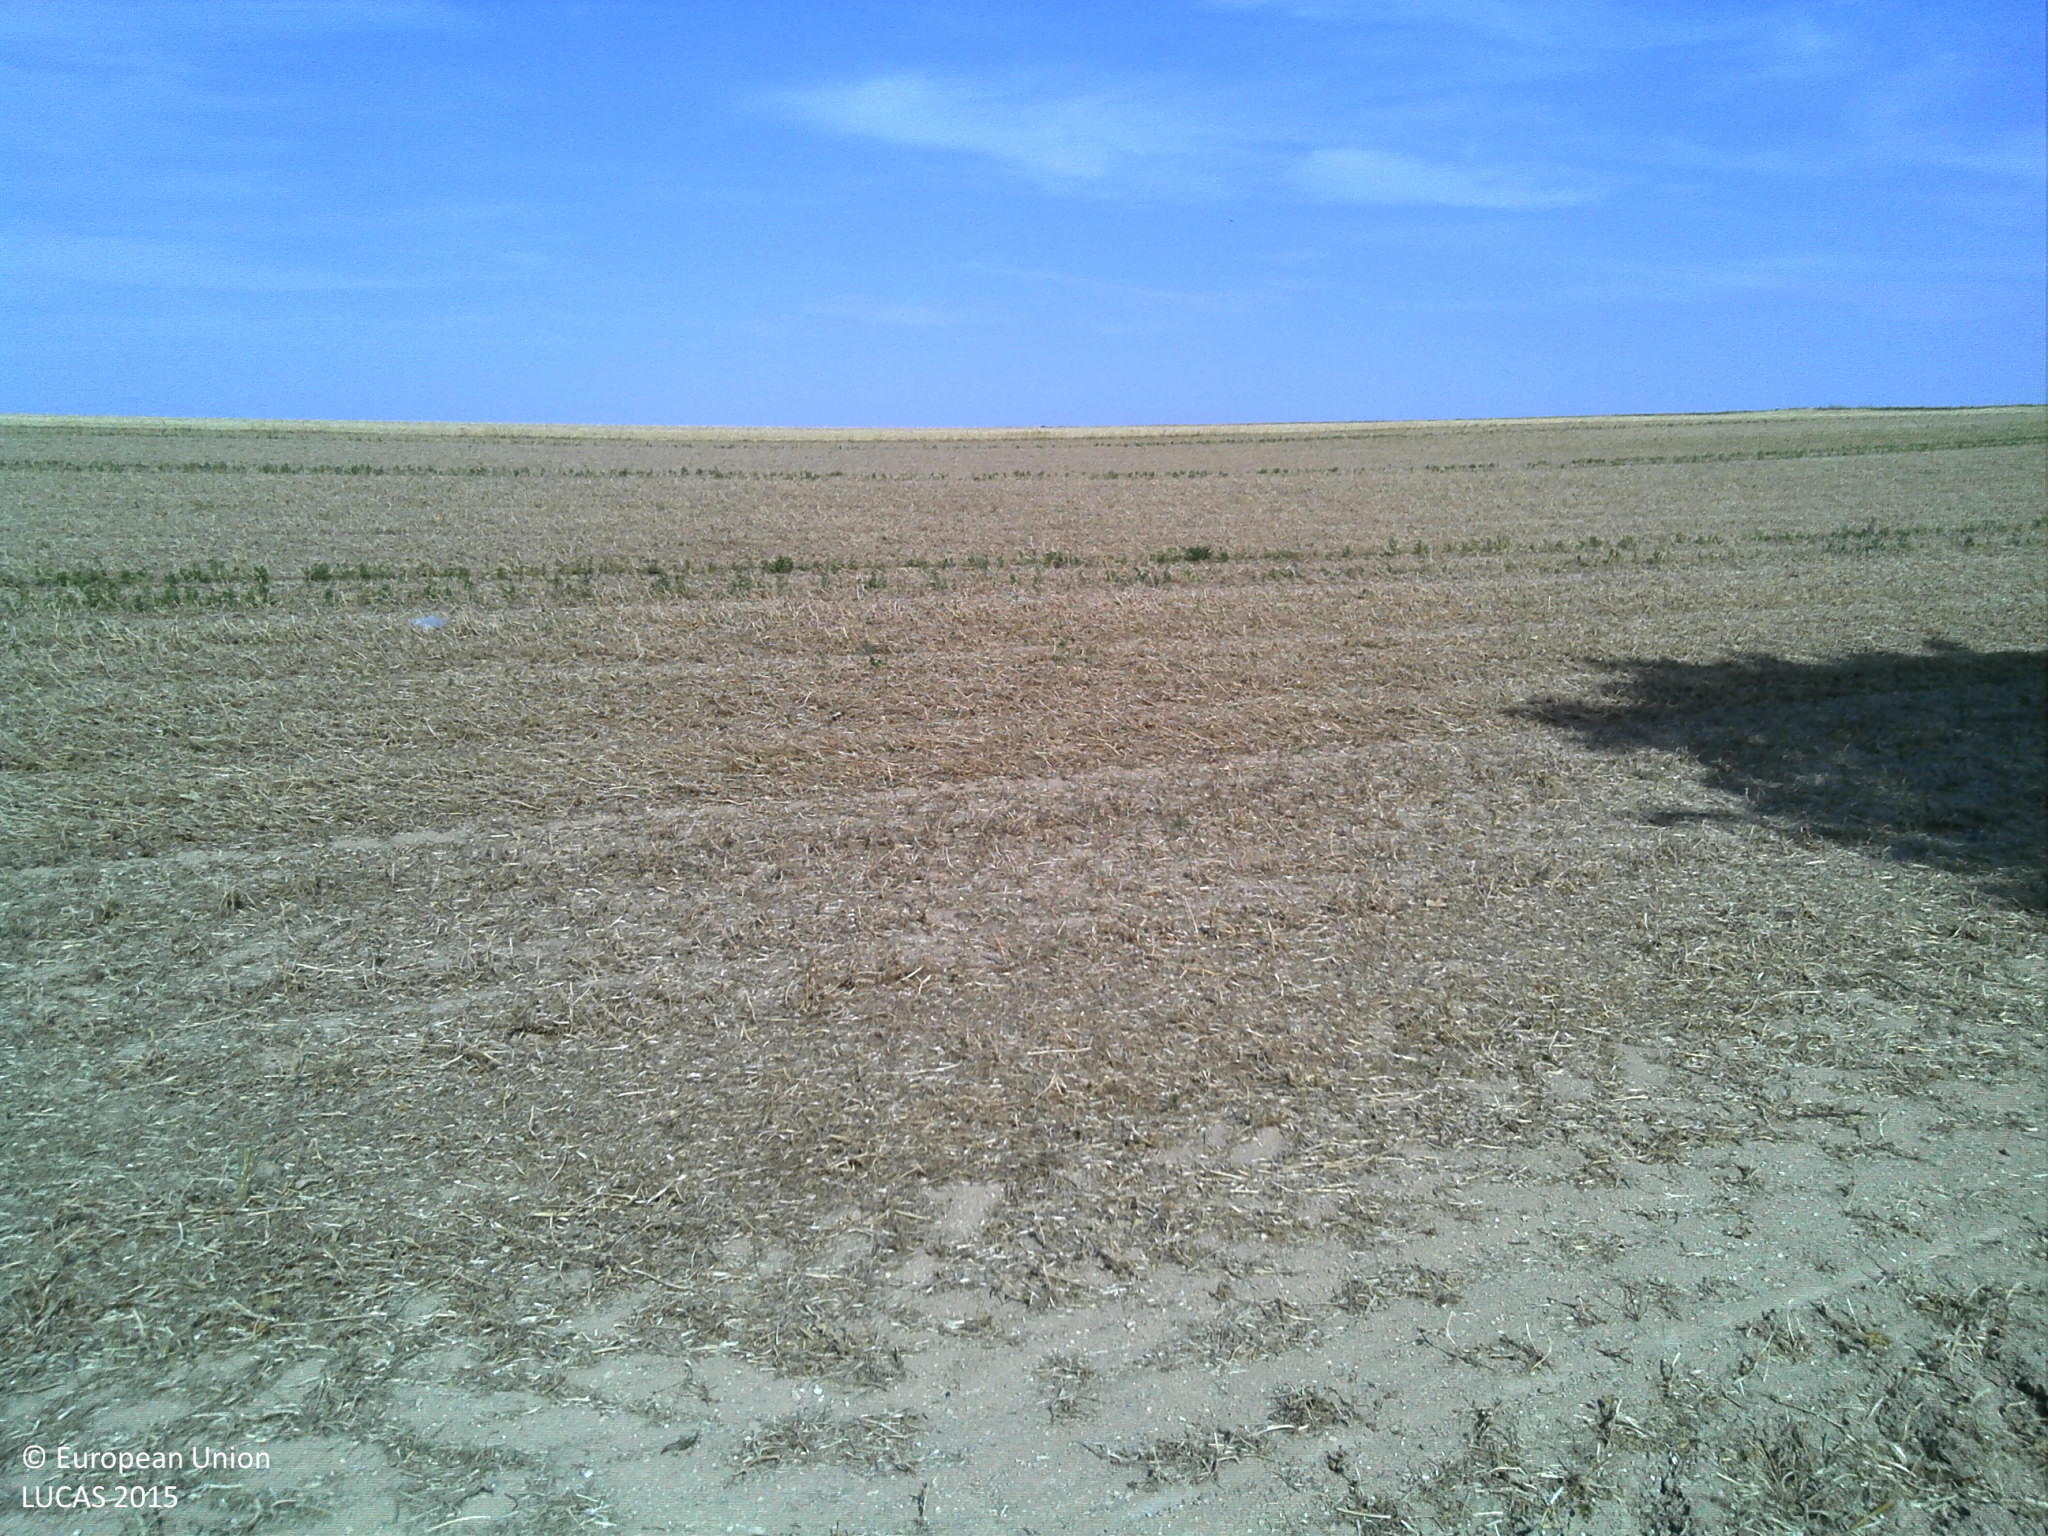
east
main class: Grassland
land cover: Grassland without tree/shrub cover
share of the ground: > 75 %
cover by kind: herbaceous plants 95 %, shrubs 5 %
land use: Road transport
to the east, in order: Grassland without tree/shrub cover; Dry pulses; Sugar beet; Common wheat; Rape and turnip rape; Common wheat; Grass margins; Tracks; Grass margins; Common wheat
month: August
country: FR
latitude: 49.0902
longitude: 4.7526
